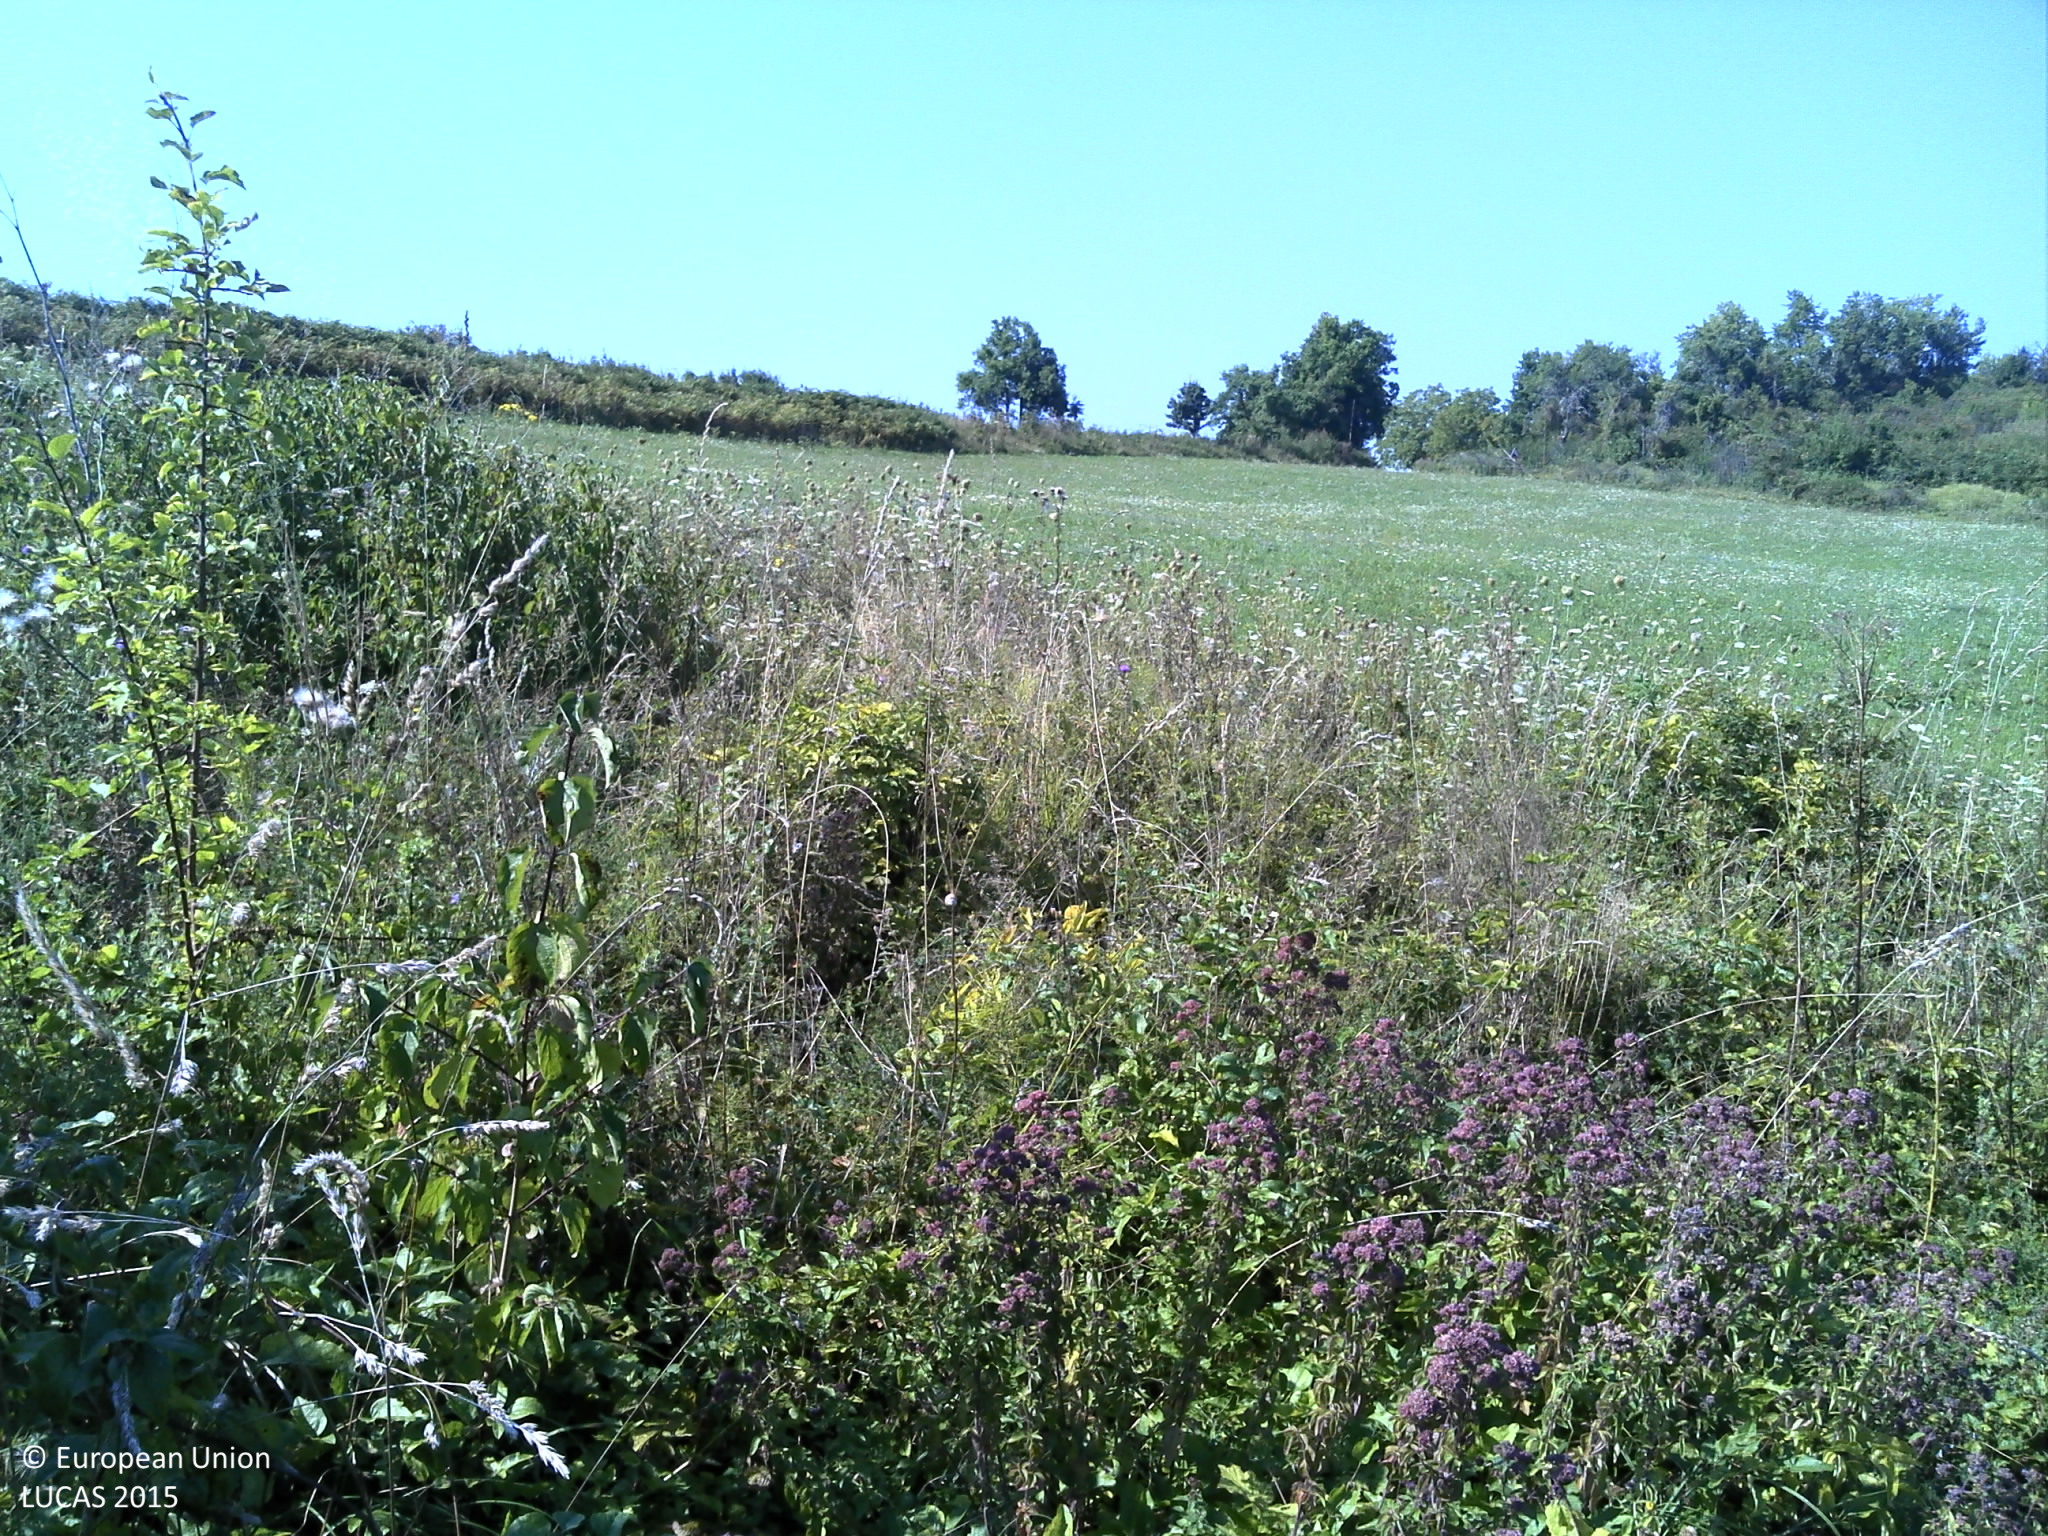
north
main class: Grassland
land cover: Spontaneously vegetated surfaces
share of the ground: > 75 %
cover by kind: herbaceous plants 100 %
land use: Semi-natural and natural areas not in use
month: August
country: HR
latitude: 45.1853
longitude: 16.3731
